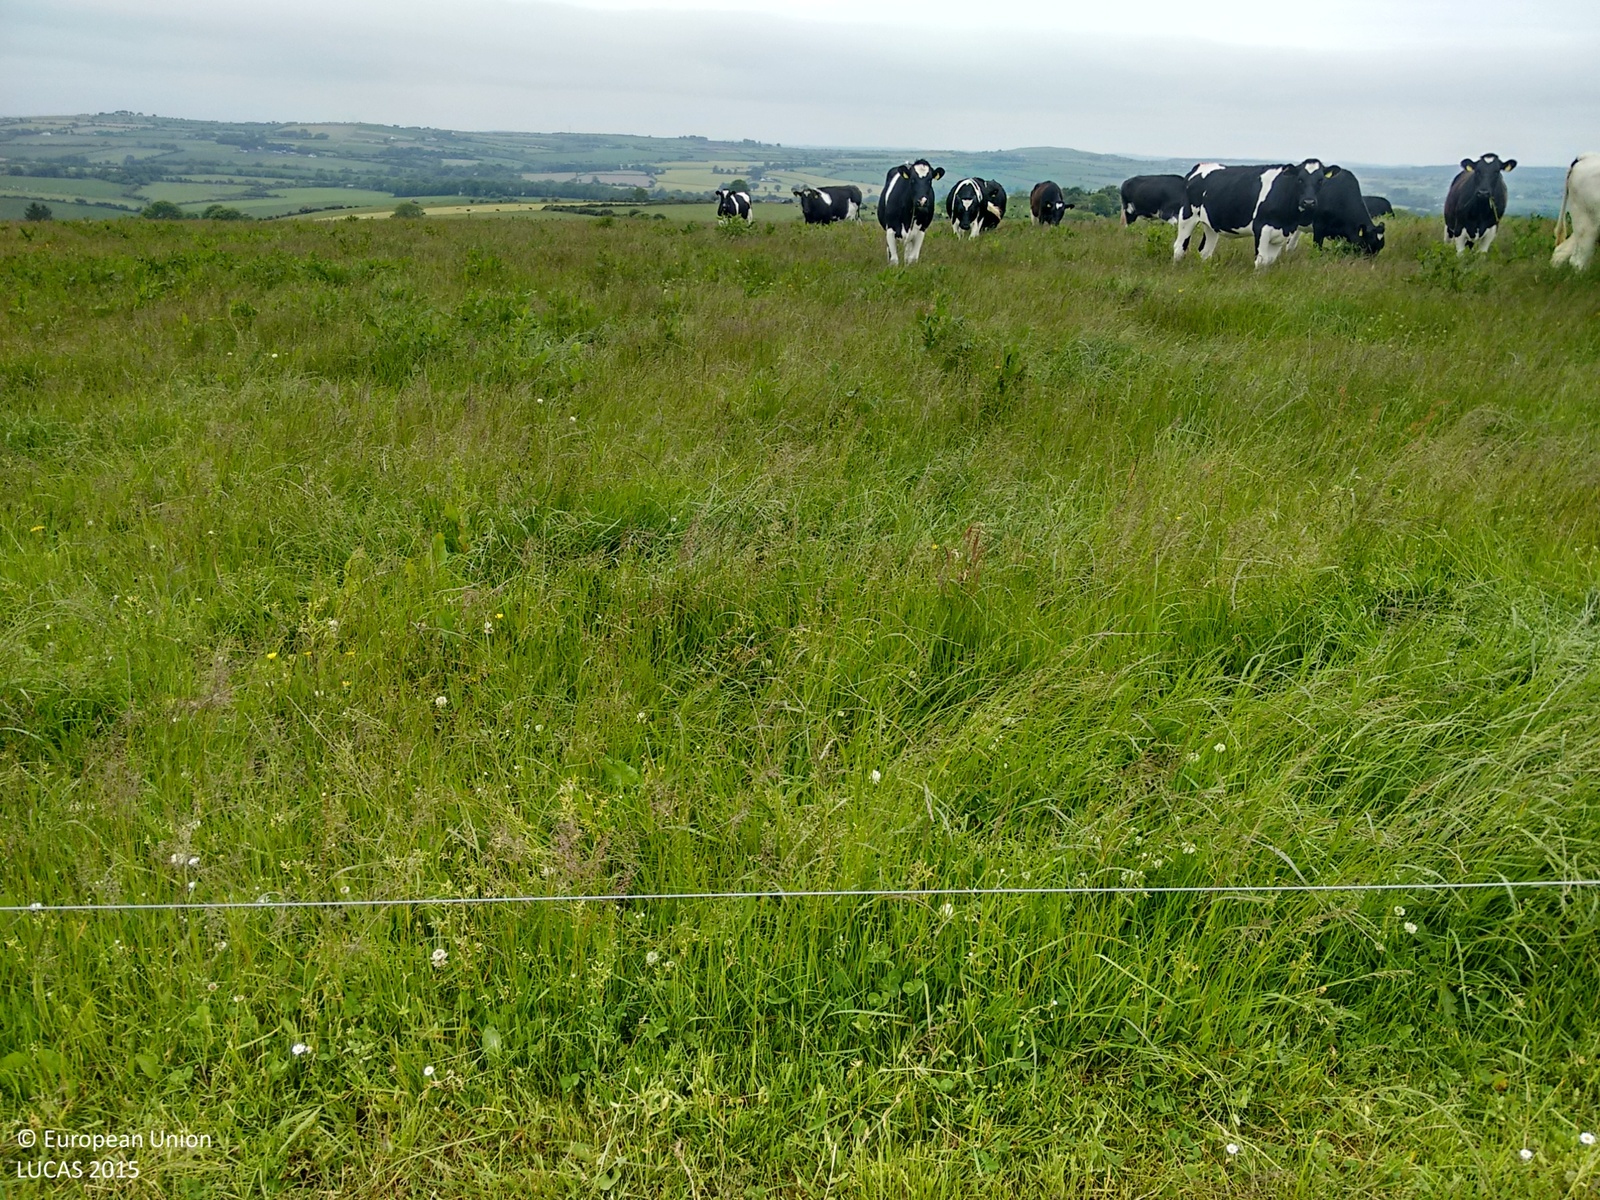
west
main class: Grassland
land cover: Grassland without tree/shrub cover
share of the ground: > 75 %
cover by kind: herbaceous plants 100 %
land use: Agriculture (excluding fallow land and kitchen gardens)
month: June
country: IE
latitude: 51.9702
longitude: -8.0679
